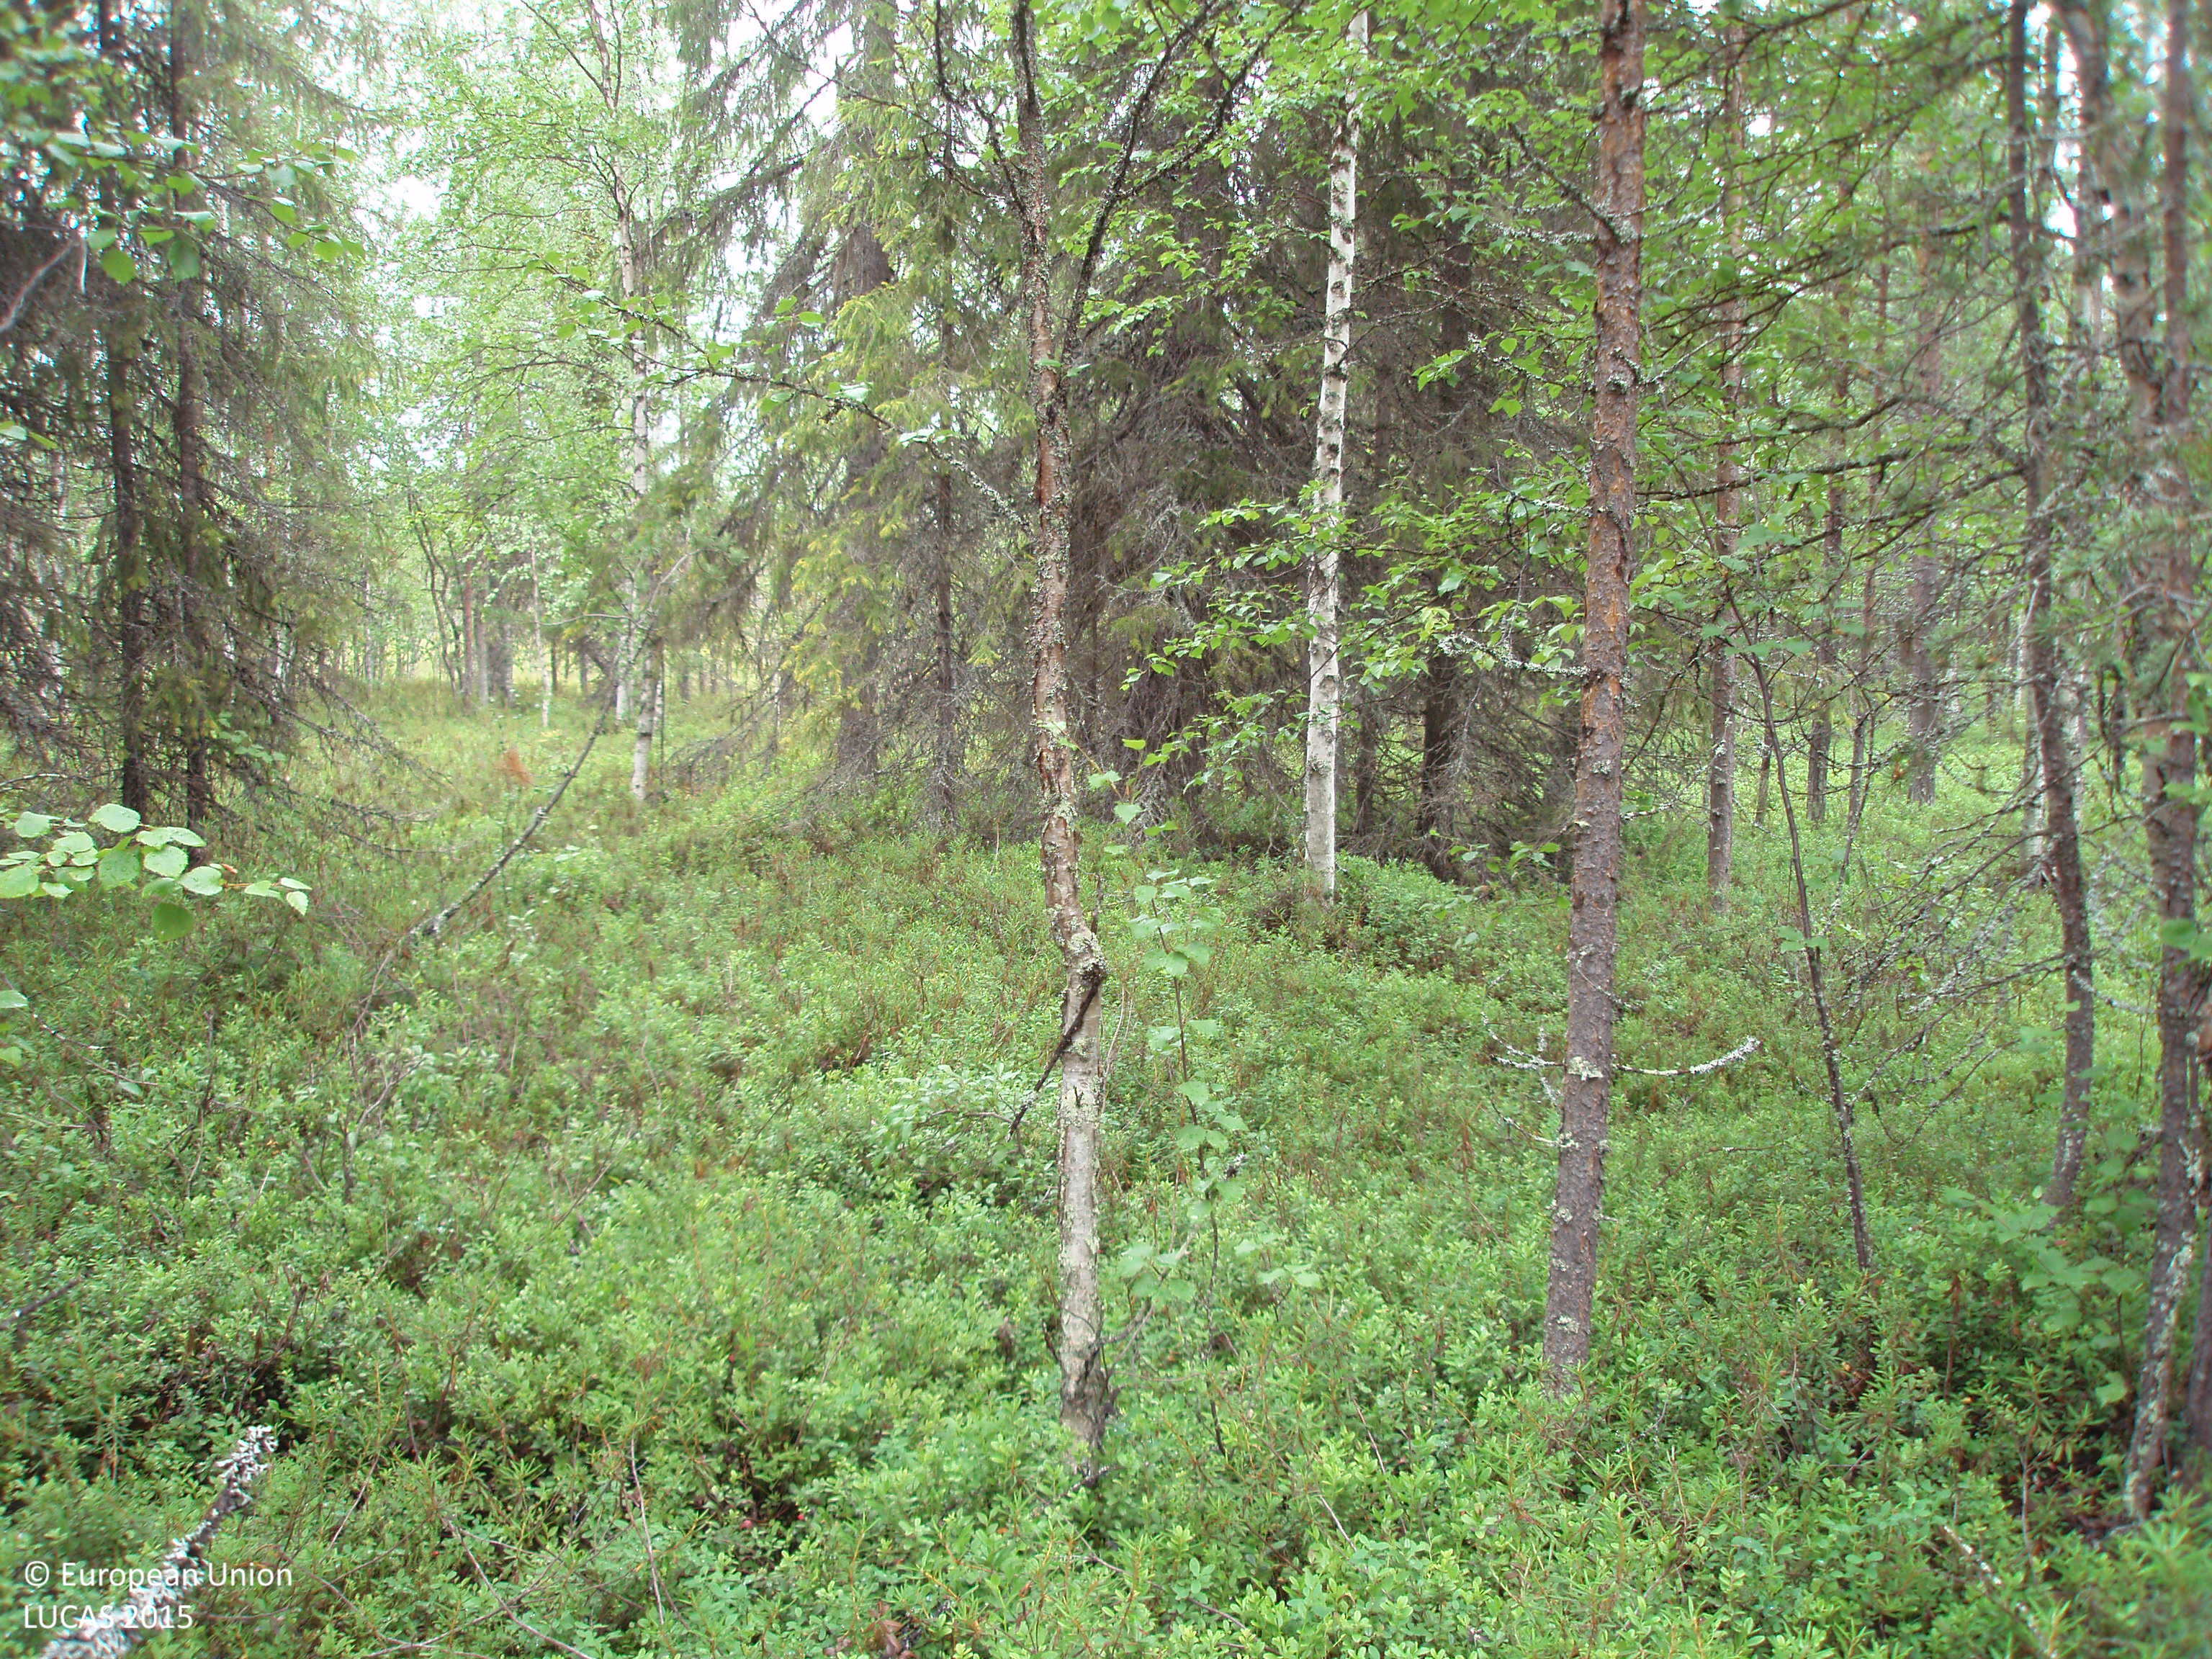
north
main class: Woodland
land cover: Other mixed woodland
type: boreal forest
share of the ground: > 75 %
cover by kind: coniferous forest trees 40 %, broadleaved forest trees 40 %, shrubs 20 %
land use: Forestry
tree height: > 5 m
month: July
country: FI
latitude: 67.1532
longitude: 27.5774
